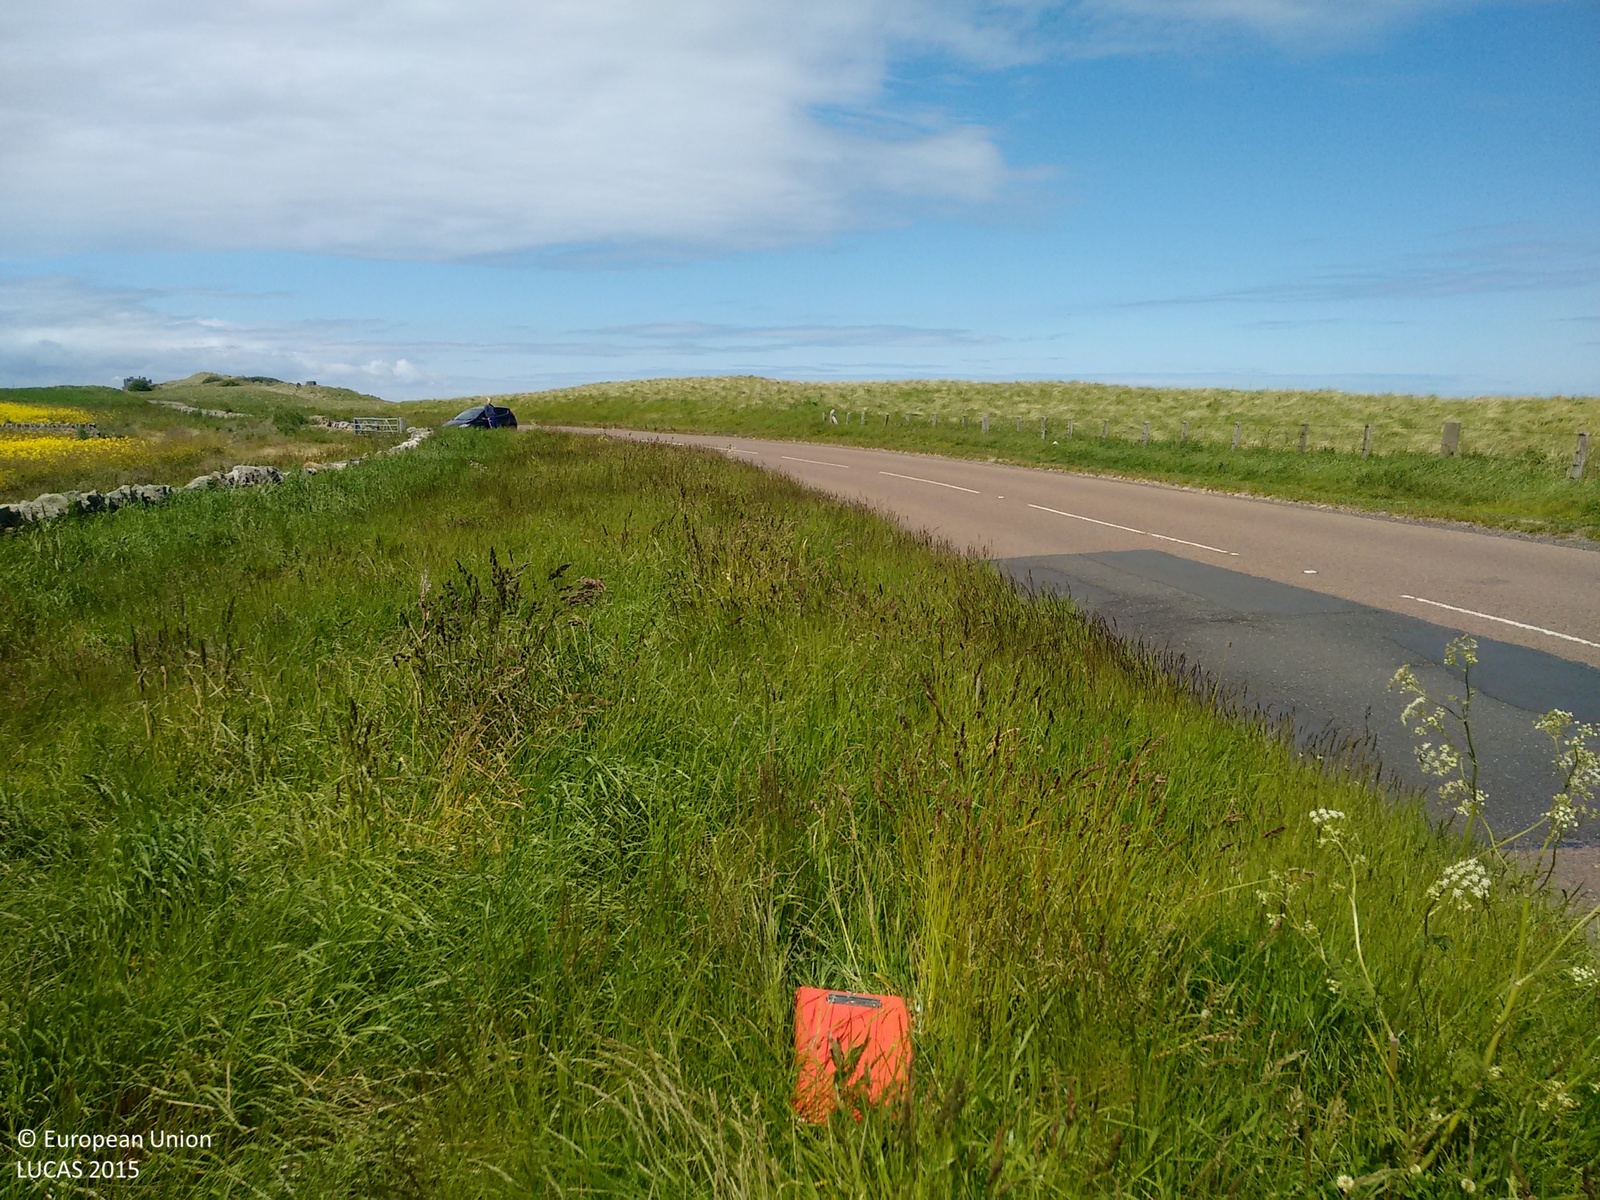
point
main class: Grassland
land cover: Grassland without tree/shrub cover
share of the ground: > 75 %
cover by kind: herbaceous plants 100 %
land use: Road transport
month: June
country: GB
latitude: 55.5976
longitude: -1.6808
